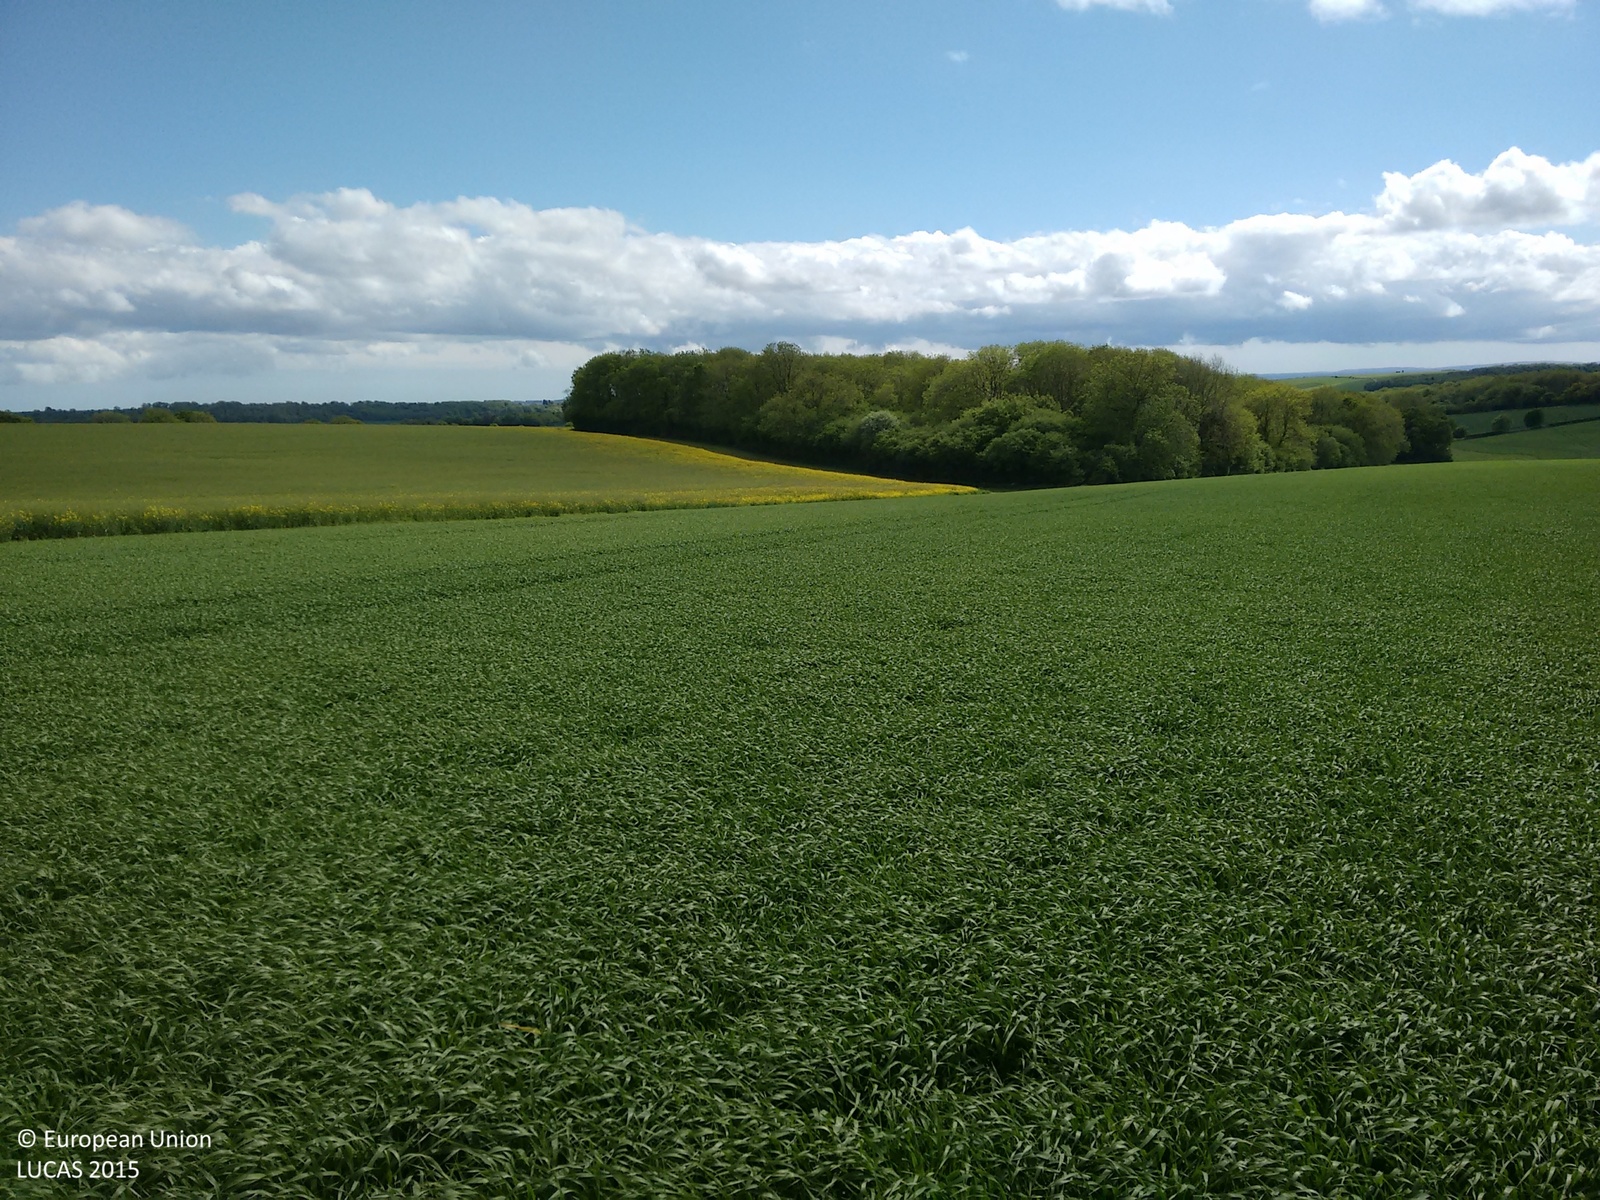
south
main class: Cropland
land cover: Barley
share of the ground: > 75 %
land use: Agriculture (excluding fallow land and kitchen gardens)
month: May
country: GB
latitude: 50.9674
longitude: -1.0812
